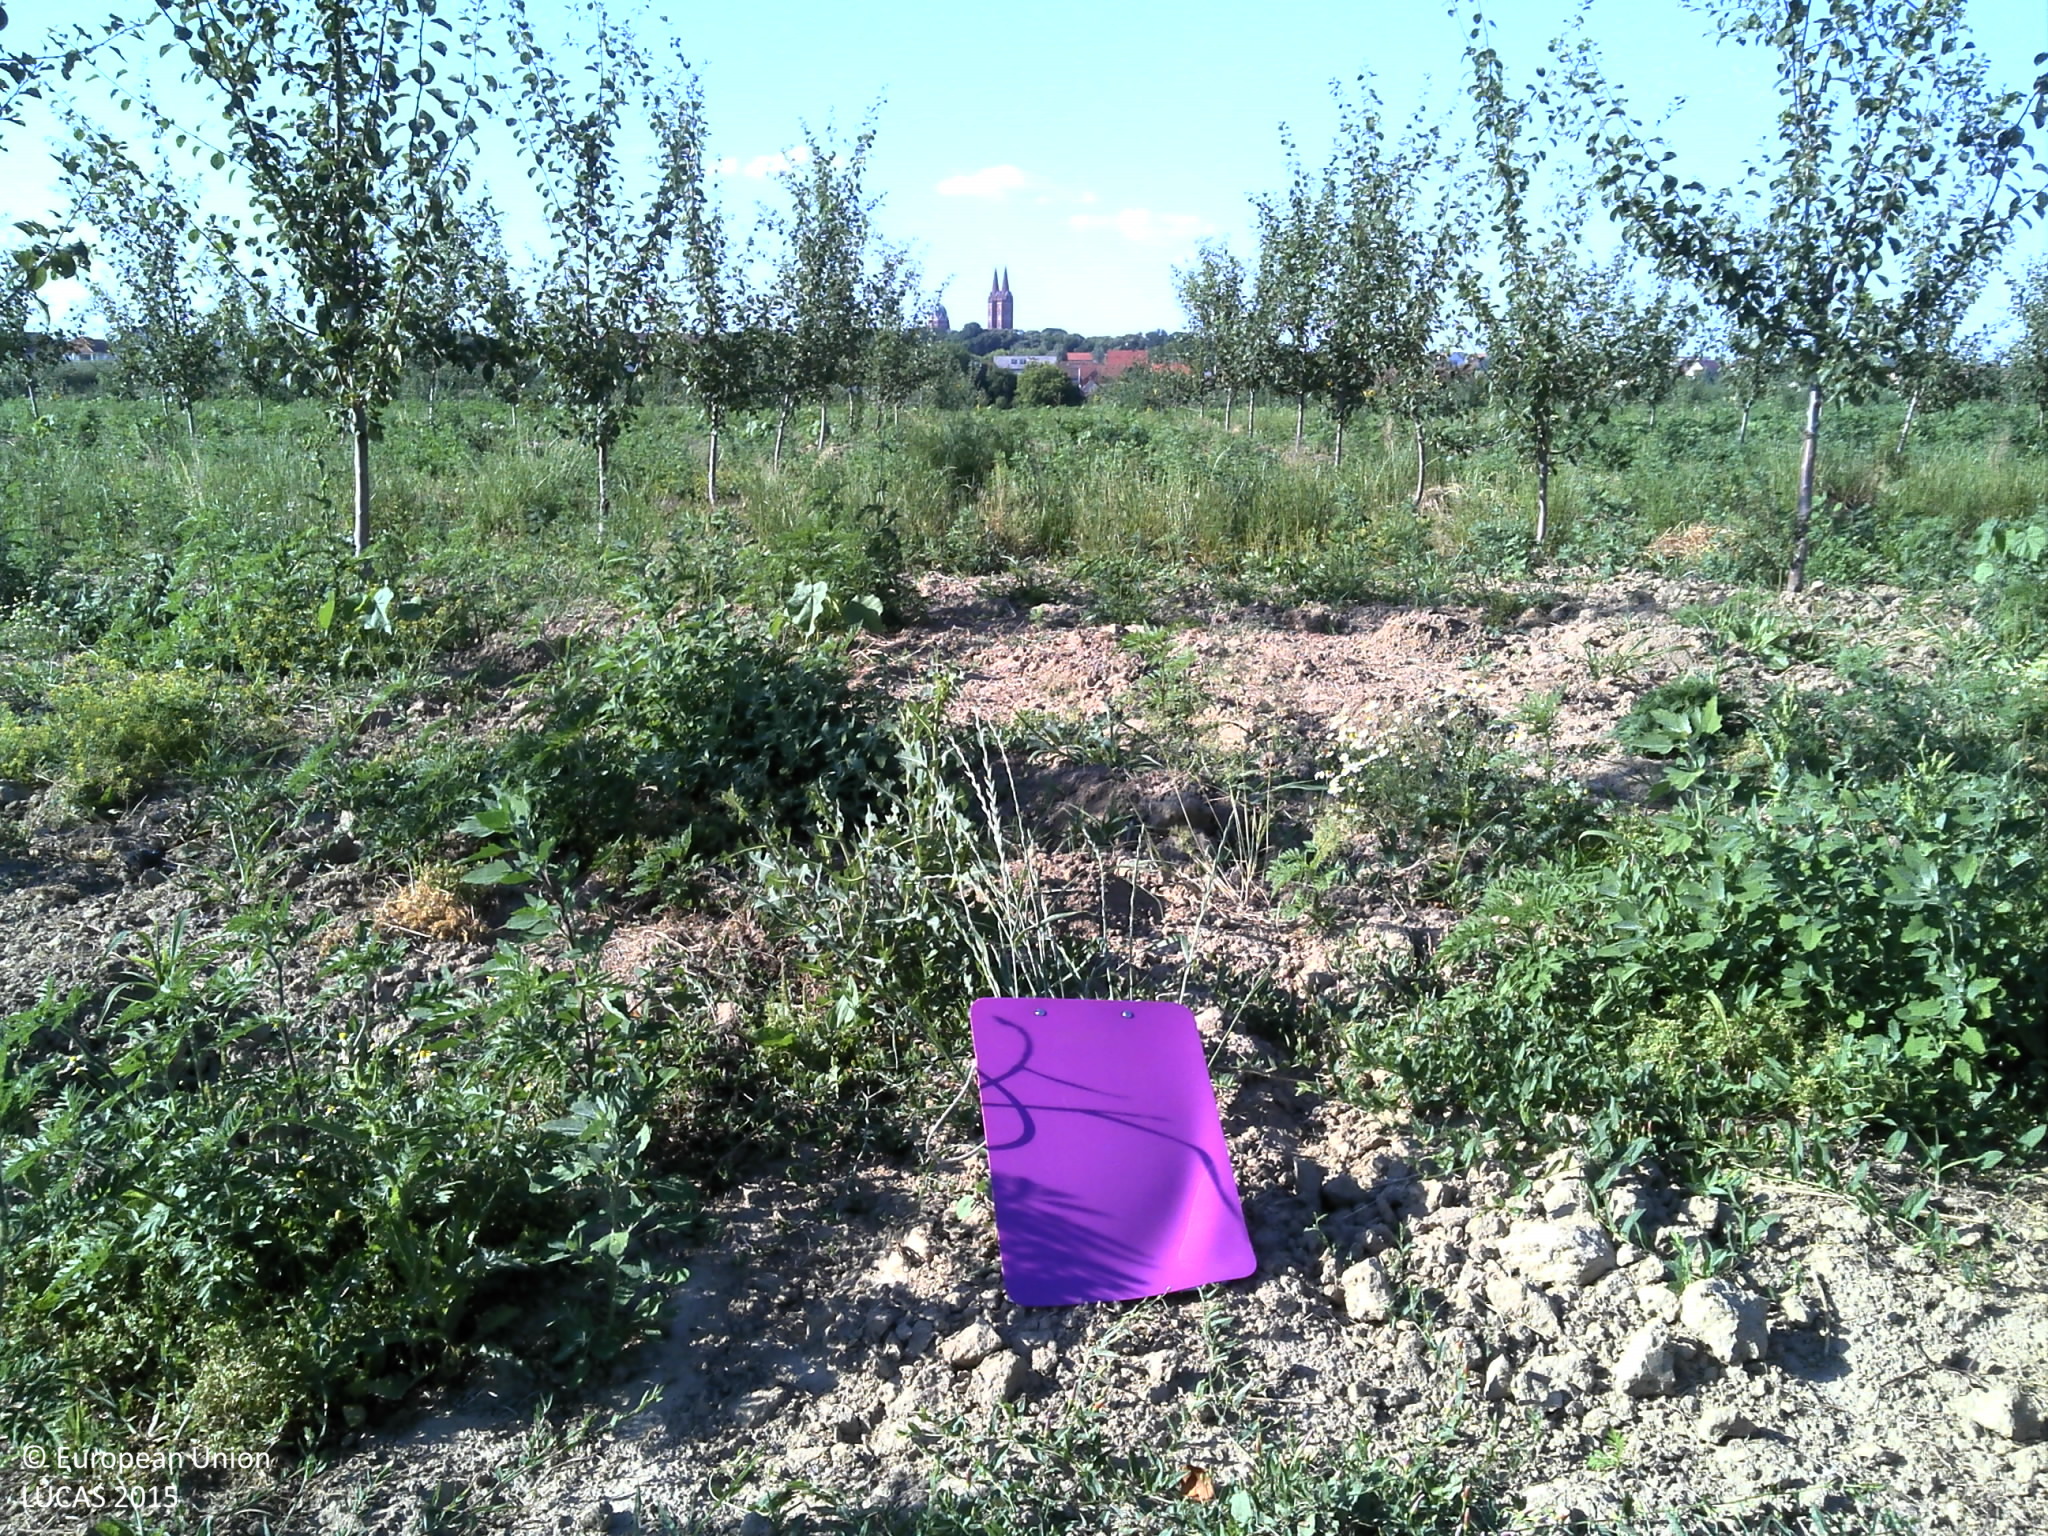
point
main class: Cropland
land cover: Other fruit trees and berries
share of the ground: 10 - 25 %
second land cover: Spontaneously vegetated surfaces
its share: 25 - 50 %
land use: Agriculture (excluding fallow land and kitchen gardens)
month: July
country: HR
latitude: 45.2953
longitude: 18.4082
